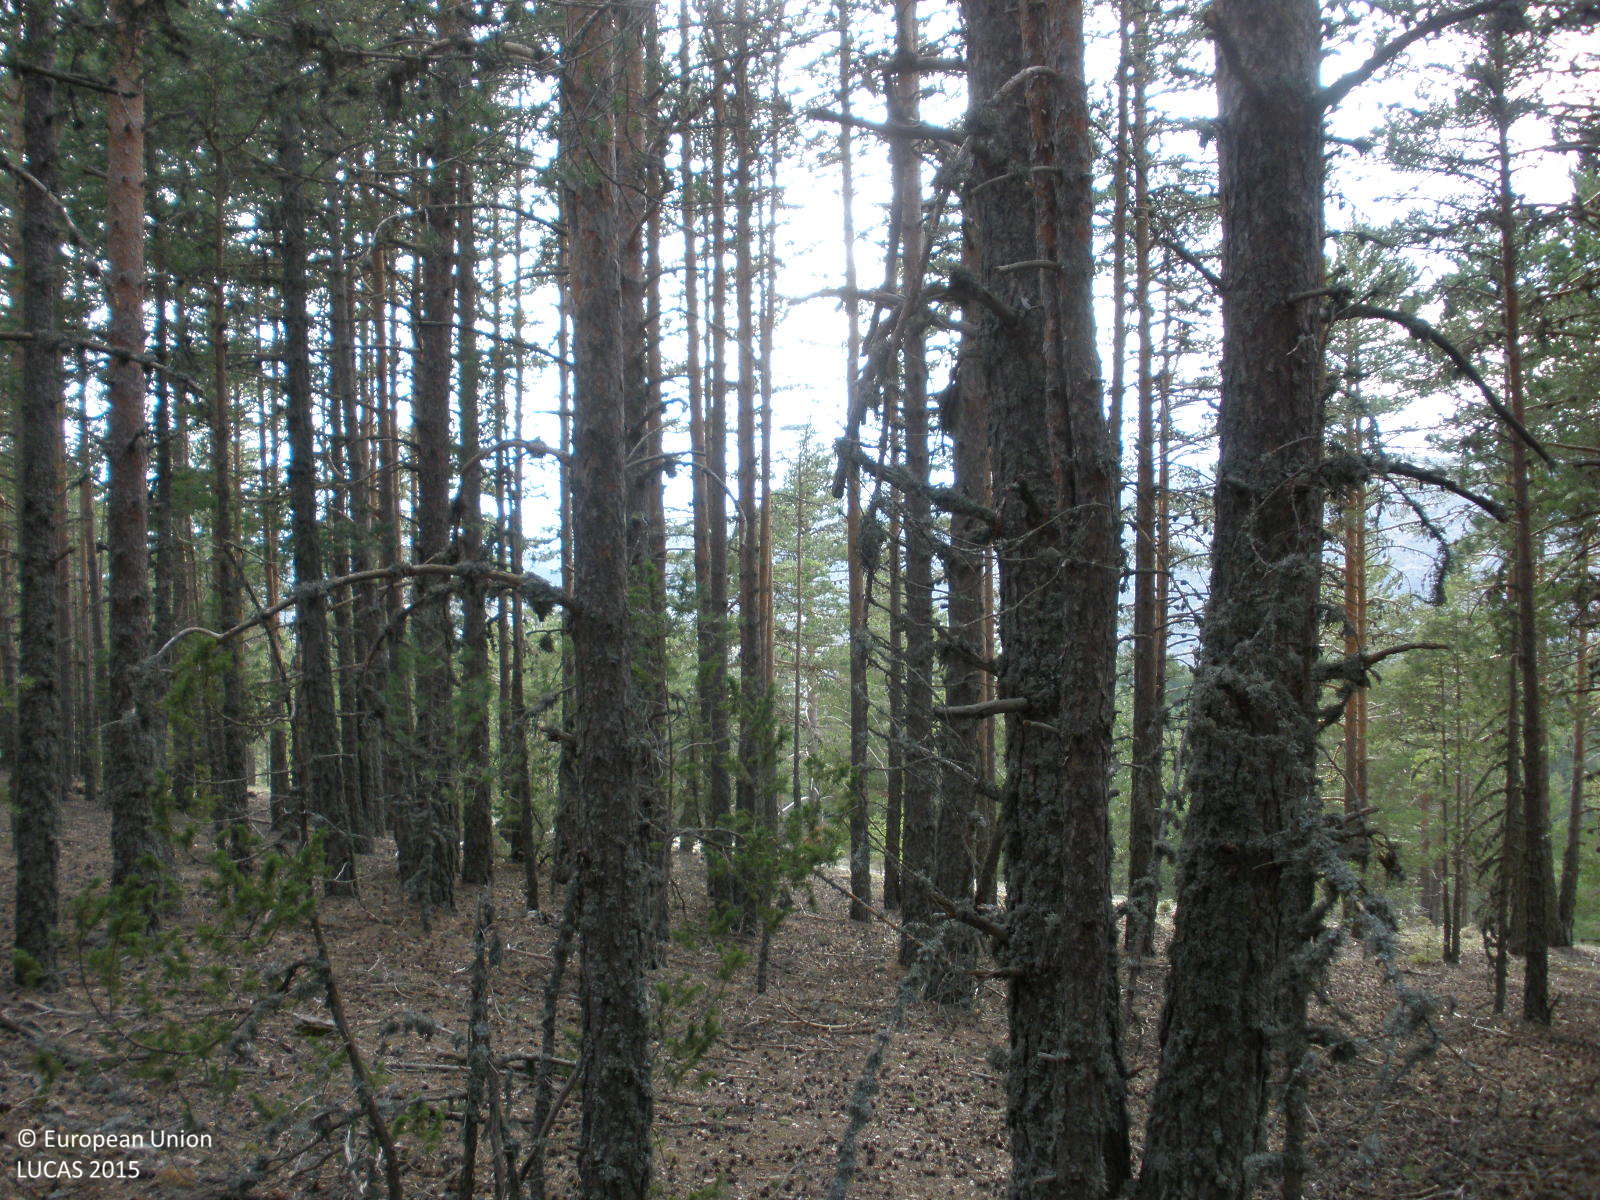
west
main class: Woodland
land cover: Pine dominated coniferous woodland
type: coniferous forest of the mediterranean region
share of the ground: > 75 %
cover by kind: coniferous forest trees 90 %, consolidated bare surface 10 %
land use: Semi-natural and natural areas not in use
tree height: > 5 m
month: April
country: ES
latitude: 40.1183
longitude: -1.0255
